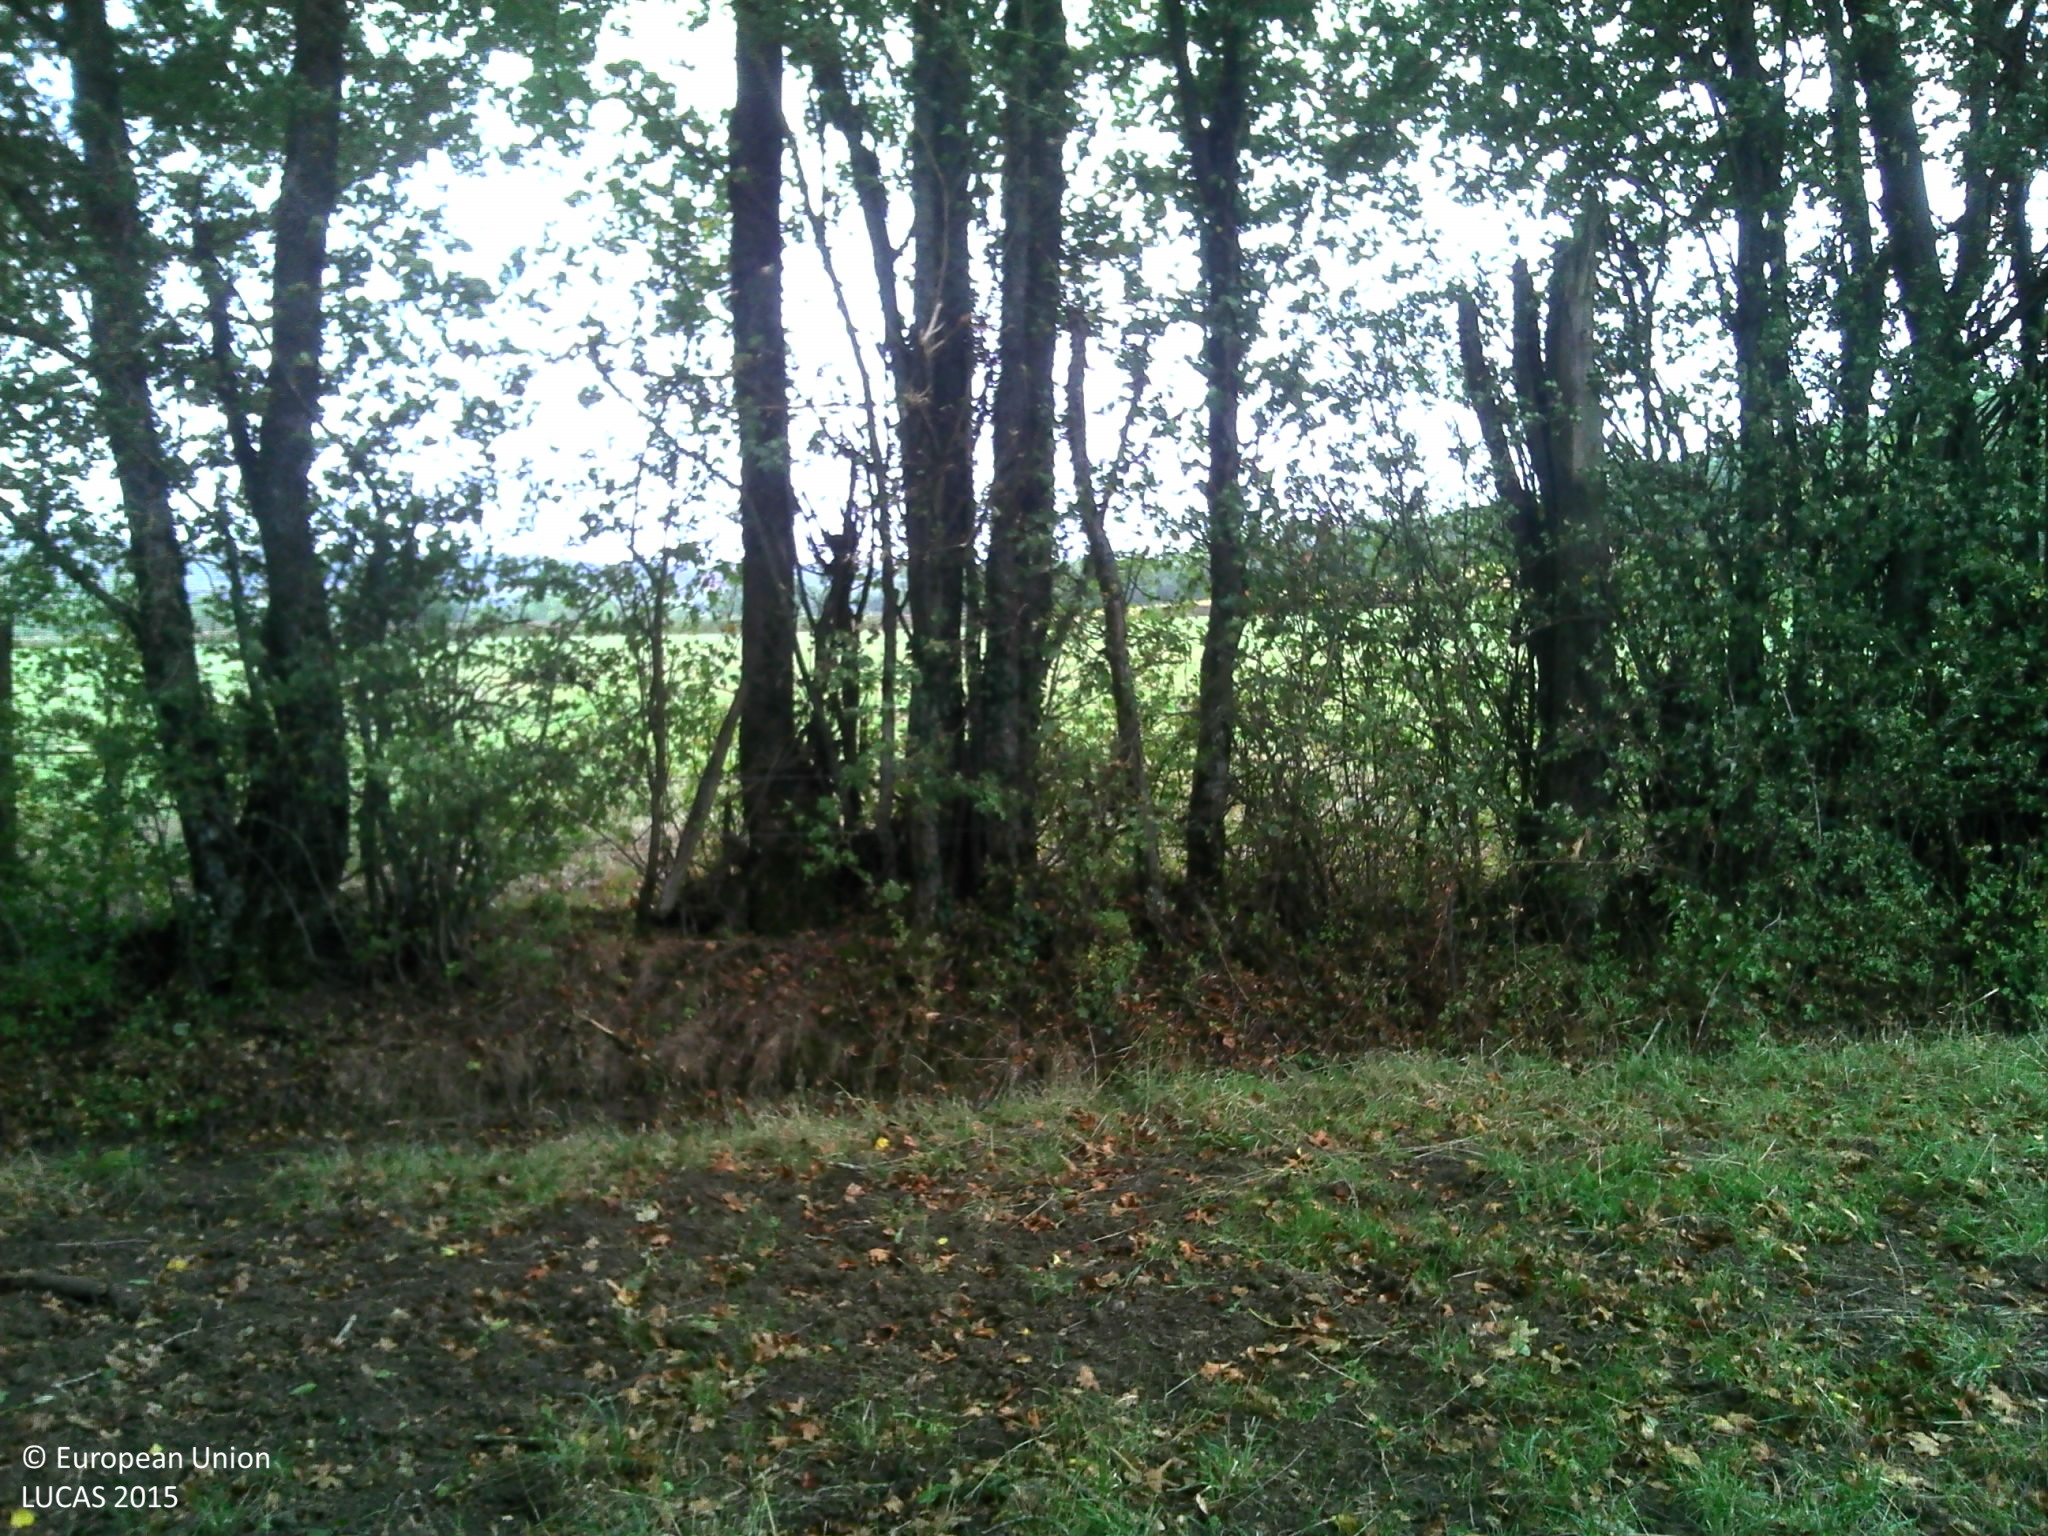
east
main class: Grassland
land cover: Grassland without tree/shrub cover
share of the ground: > 75 %
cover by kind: herbaceous plants 100 %
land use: Agriculture (excluding fallow land and kitchen gardens)
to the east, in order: Grassland without tree/shrub cover; Ditches and canals; Fences; Lines of trees; Grassland without tree/shrub cover; Fences; Managed hedges; Grass margins; Ditches and canals; Sunflower
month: September
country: FR
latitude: 47.4520
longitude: 4.4418
